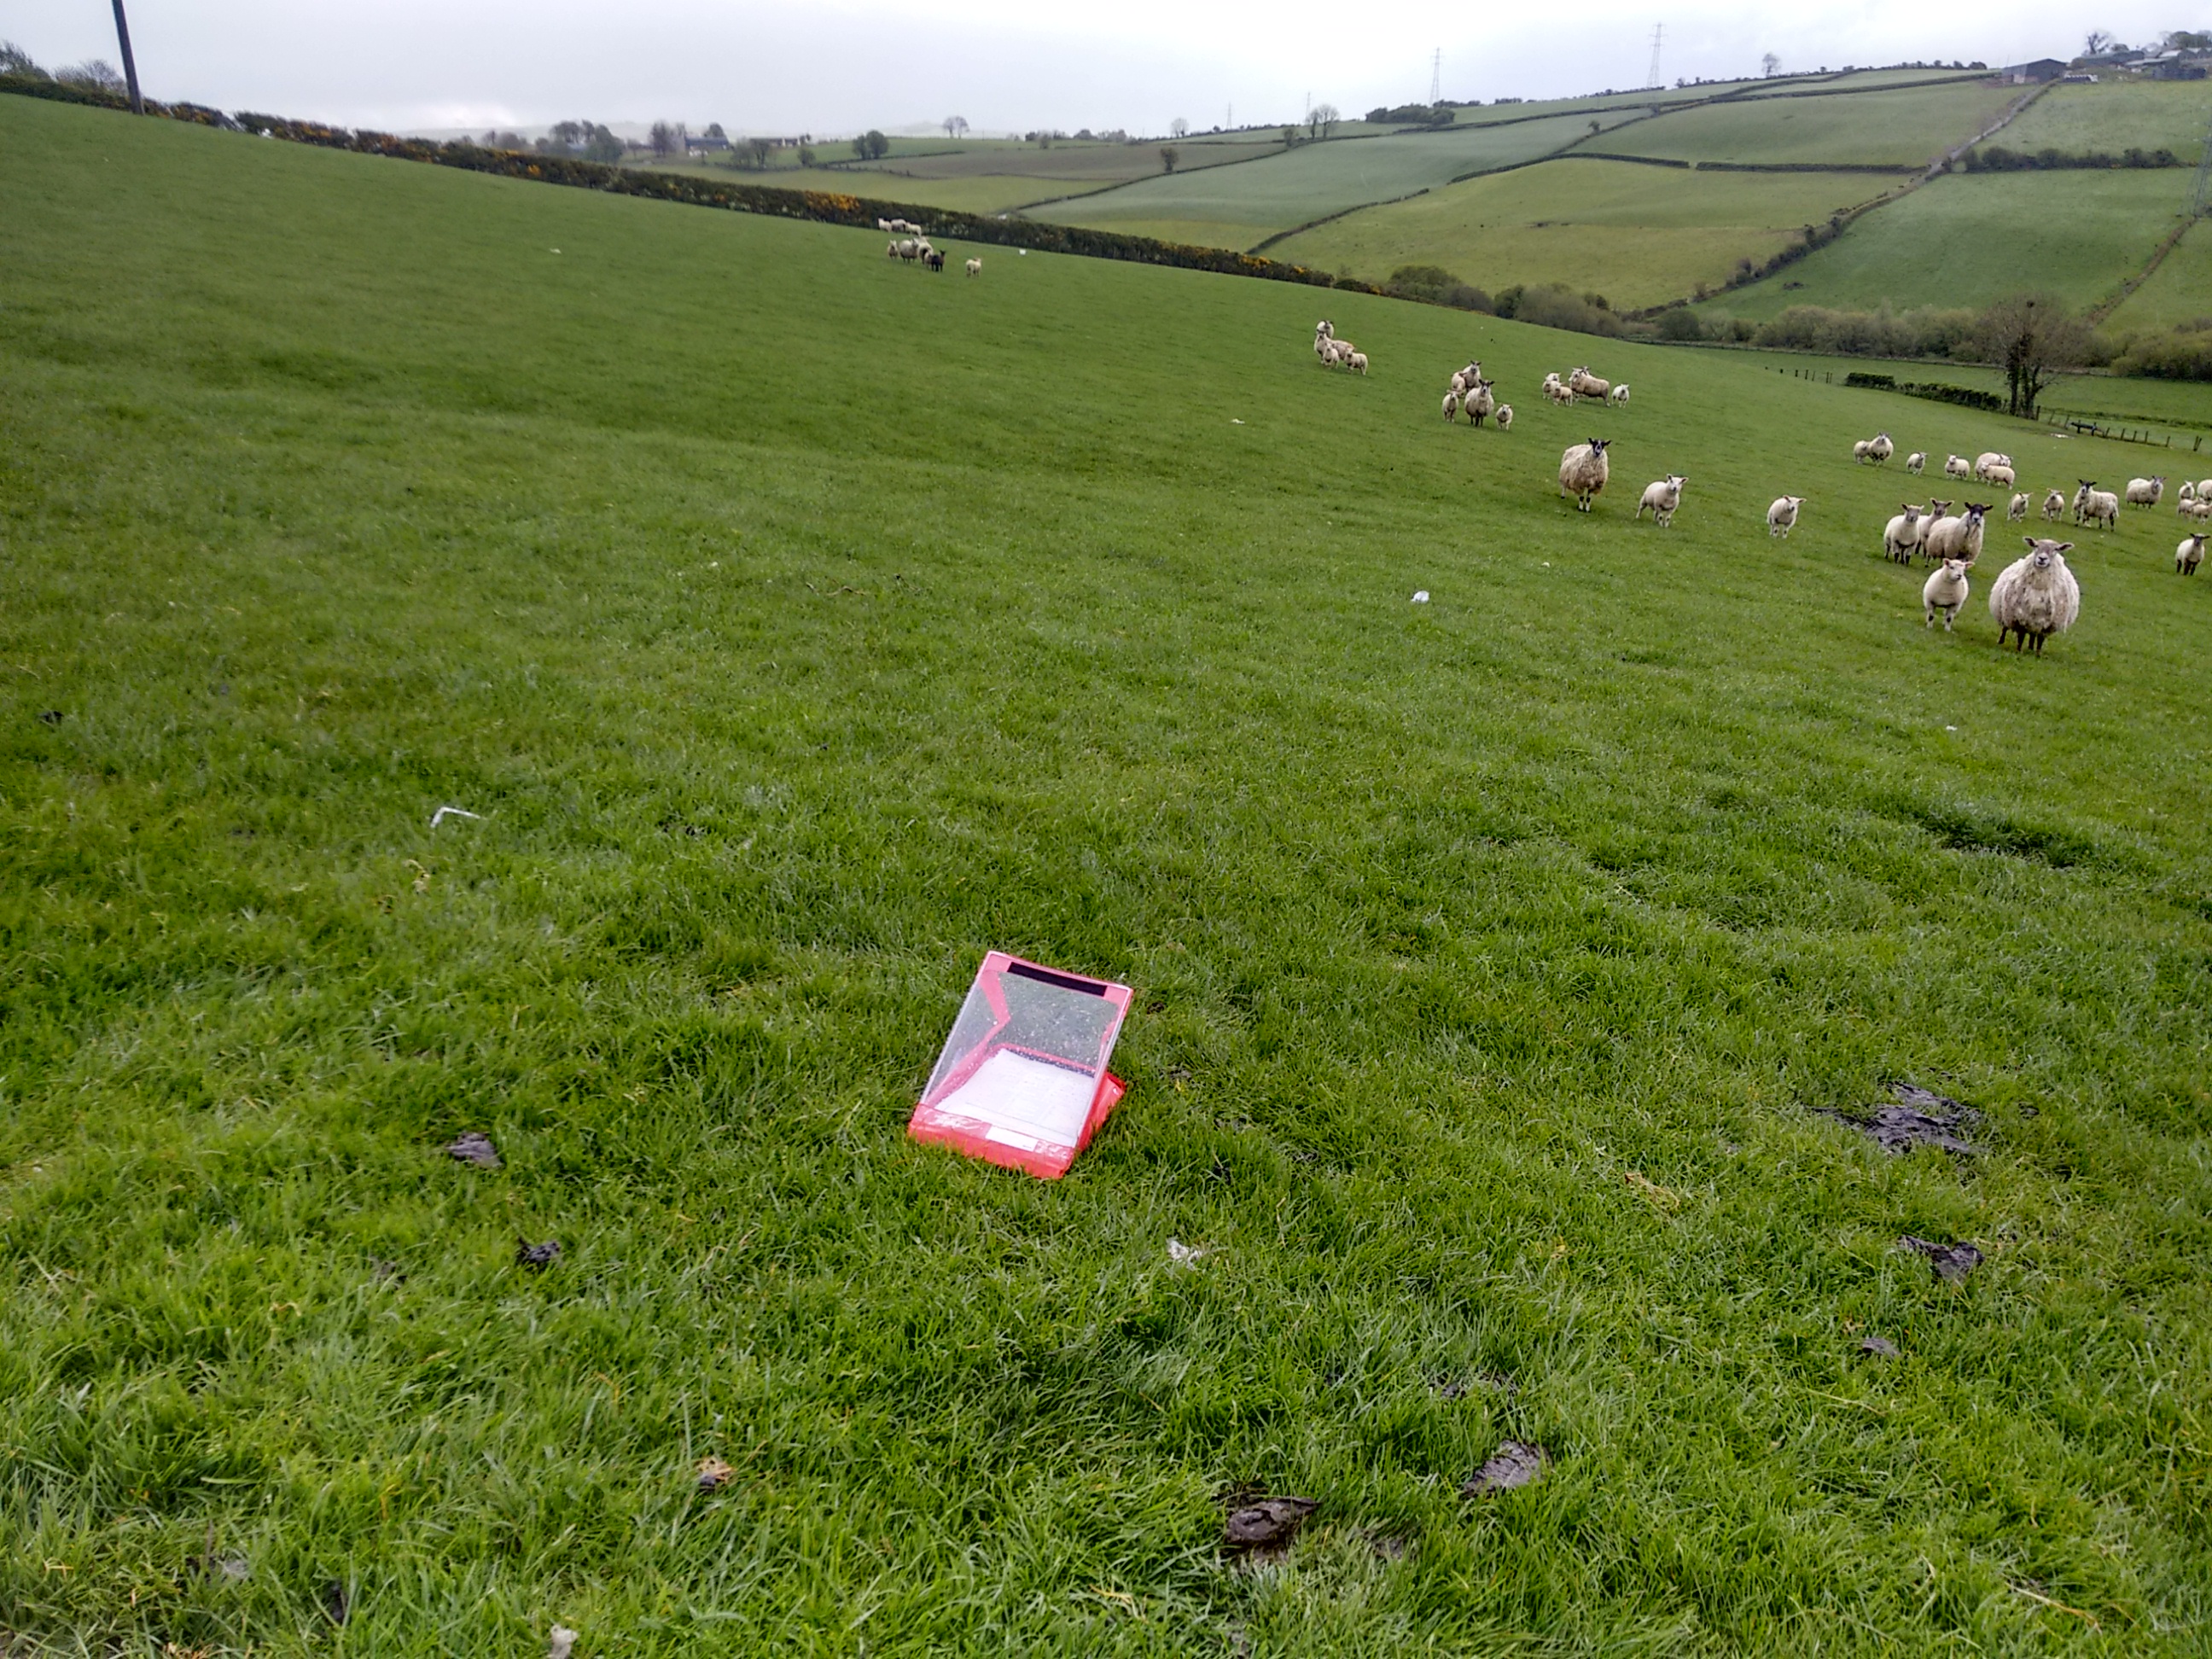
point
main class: Grassland
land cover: Grassland without tree/shrub cover
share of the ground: > 75 %
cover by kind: herbaceous plants 100 %
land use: Agriculture (excluding fallow land and kitchen gardens)
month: May
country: GB
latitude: 54.9601
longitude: -7.3116
